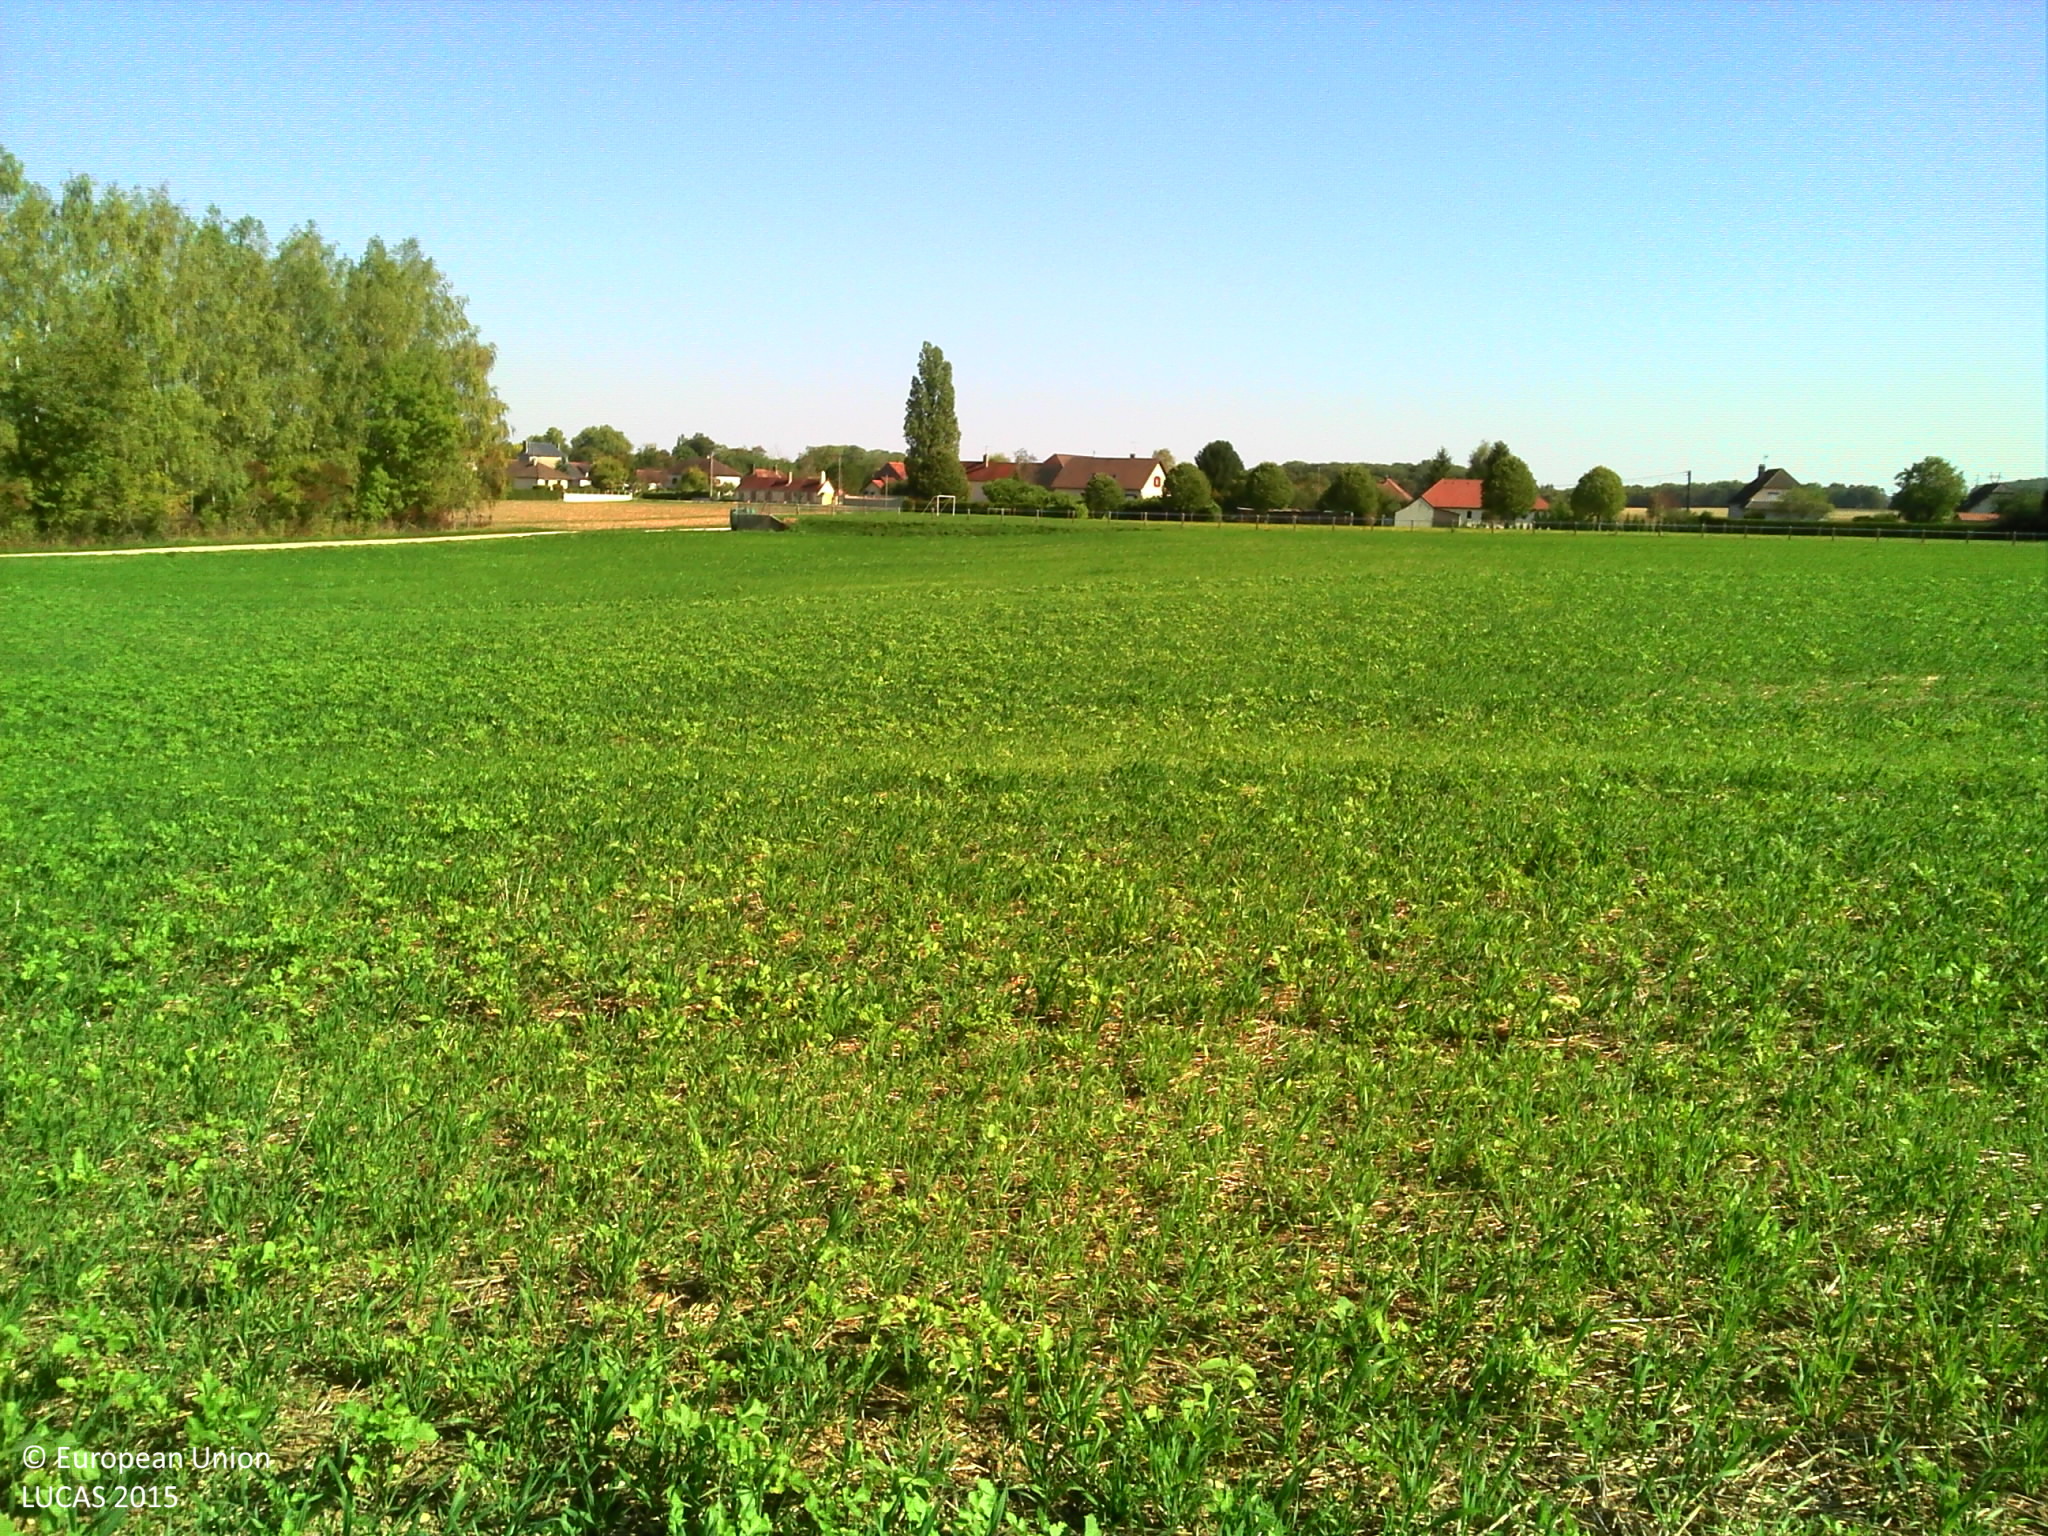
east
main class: Cropland
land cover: Other fibre and oleaginous crops
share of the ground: 50 - 75 %
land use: Agriculture (excluding fallow land and kitchen gardens)
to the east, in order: Other fibre and oleaginous crops; Grassland without tree/shrub cover; Grass margins; Fences; Grassland without tree/shrub cover; Fences; Grass margins; Tracks
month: September
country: FR
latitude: 48.1461
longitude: 4.2581
